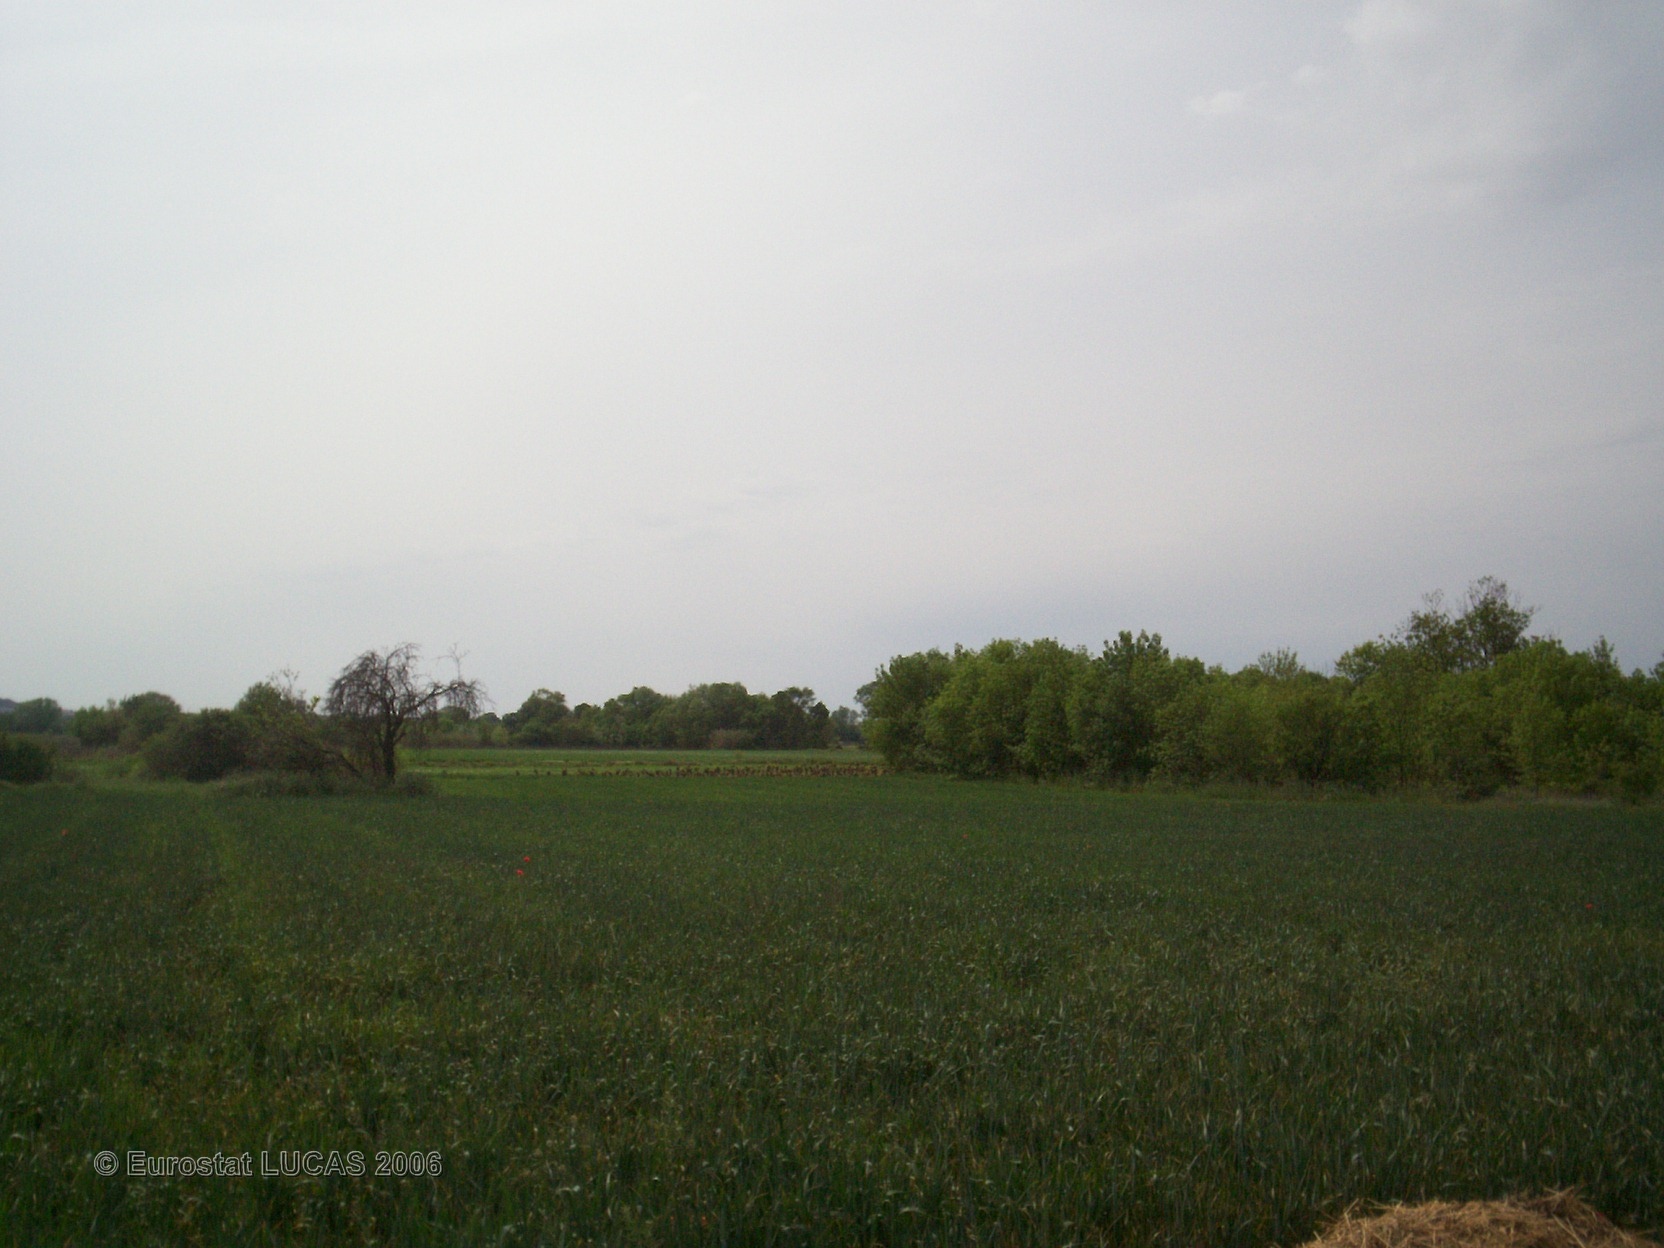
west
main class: Cropland
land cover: Common wheat
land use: Agriculture (excluding fallow land and kitchen gardens)
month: April
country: FR
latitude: 43.4018
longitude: 3.4530
